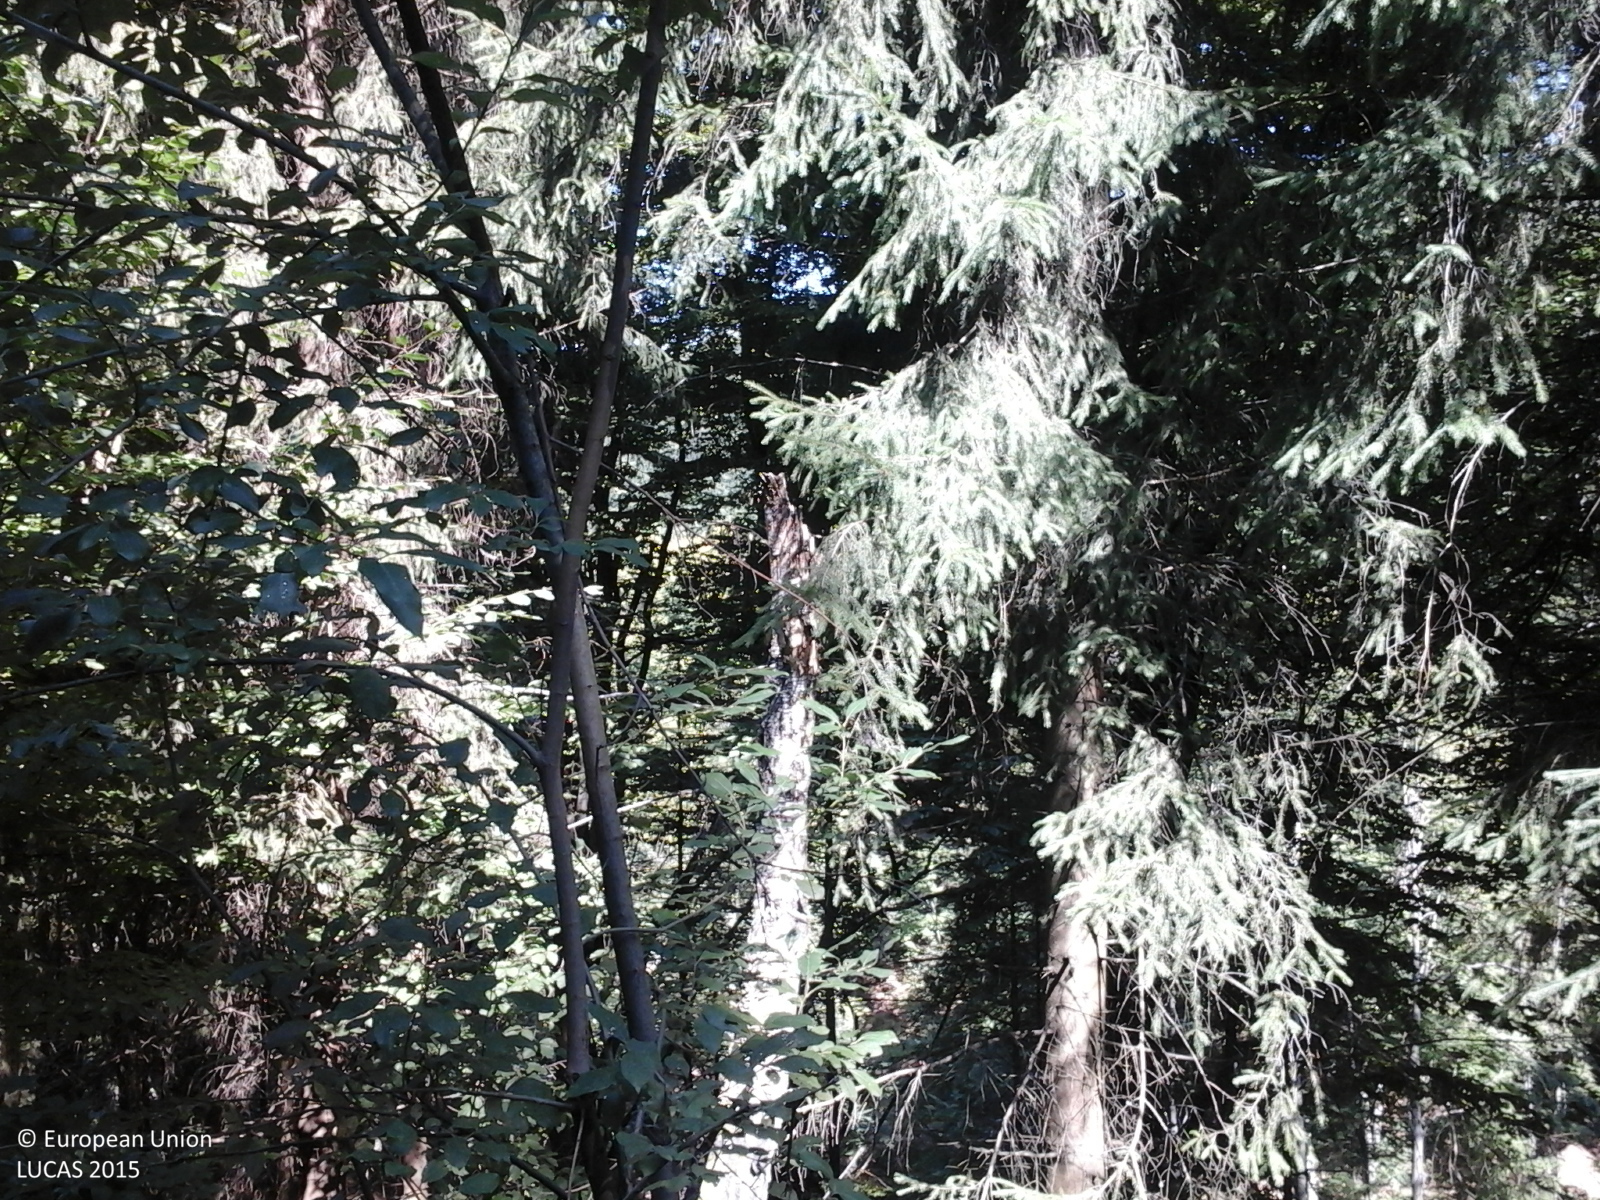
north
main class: Woodland
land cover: Spruce dominated mixed woodland
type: hemiboreal forest and nemoral coniferous forest and mixed broadleaved-coniferous forest
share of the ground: > 75 %
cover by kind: coniferous forest trees 60 %, broadleaved forest trees 40 %
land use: Forestry
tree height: > 5 m
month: September
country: RO
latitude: 46.6847
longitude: 22.5393
